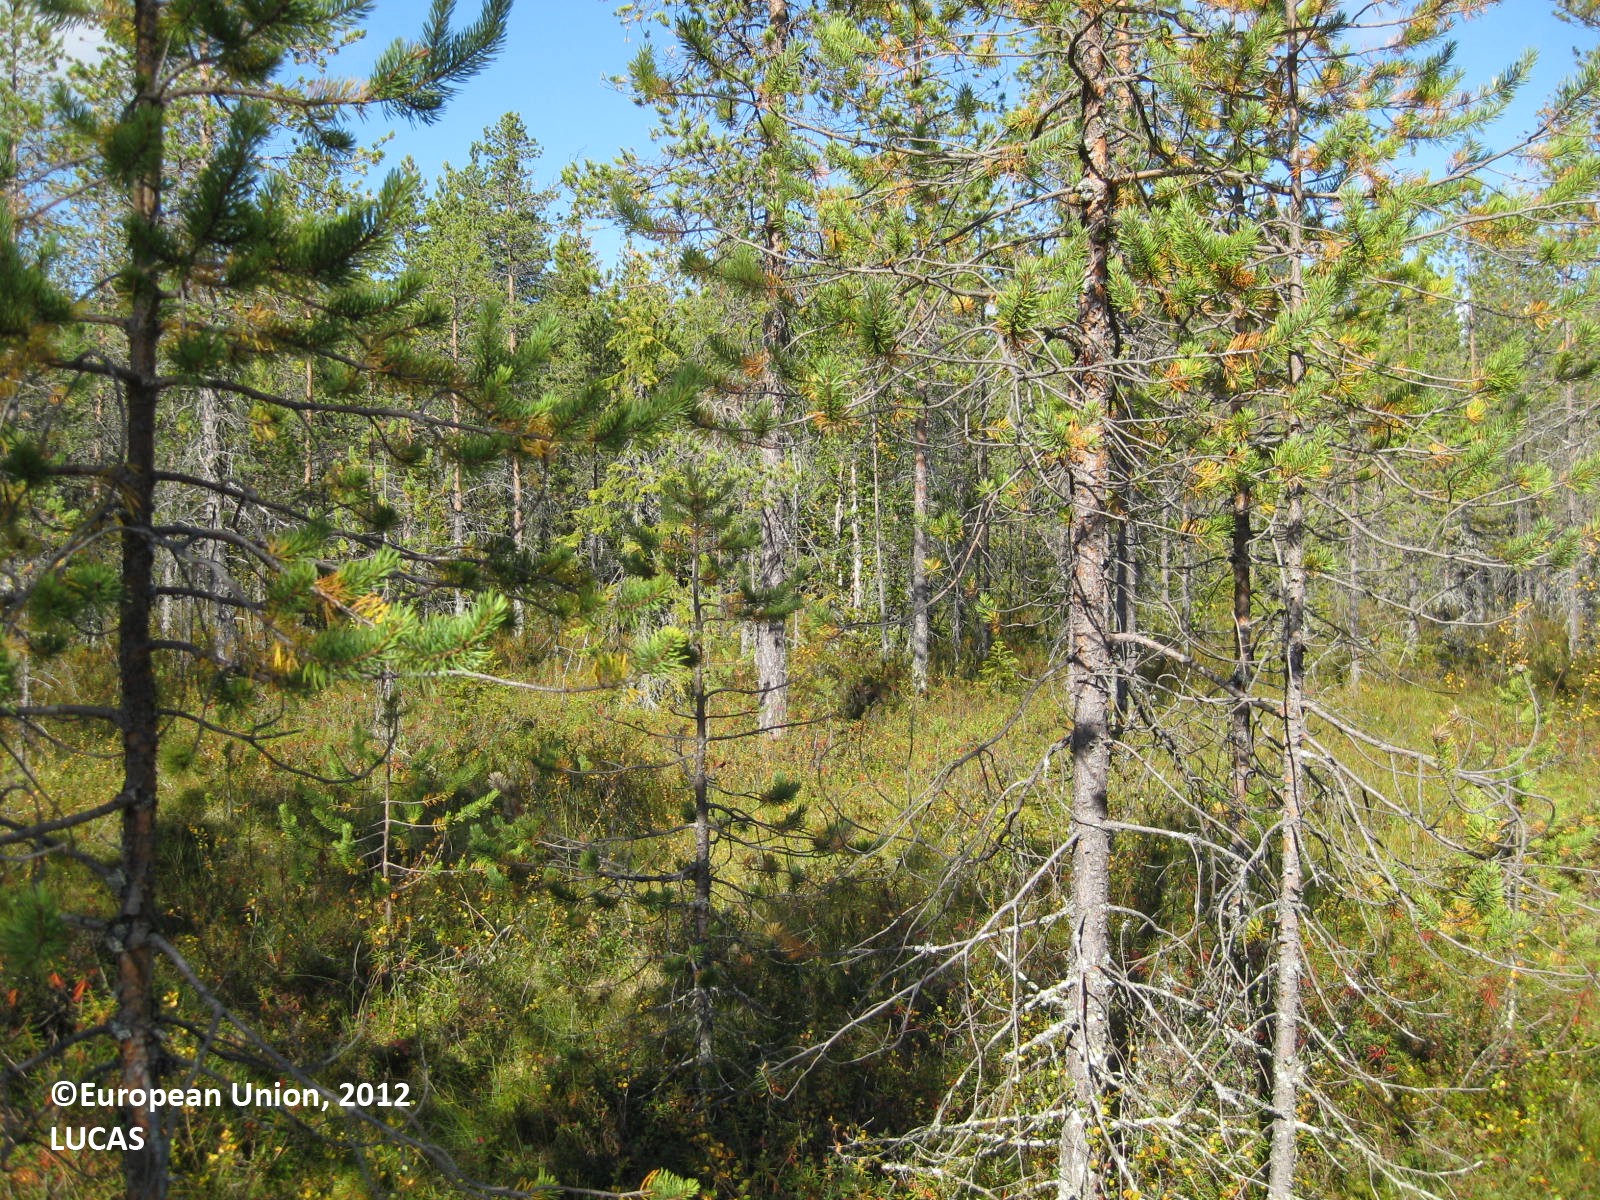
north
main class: Woodland
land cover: Pine dominated coniferous woodland
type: boreal forest
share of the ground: 50 - 75 %
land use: Forestry
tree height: > 5 m
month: August
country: FI
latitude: 66.0642
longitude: 29.6097
